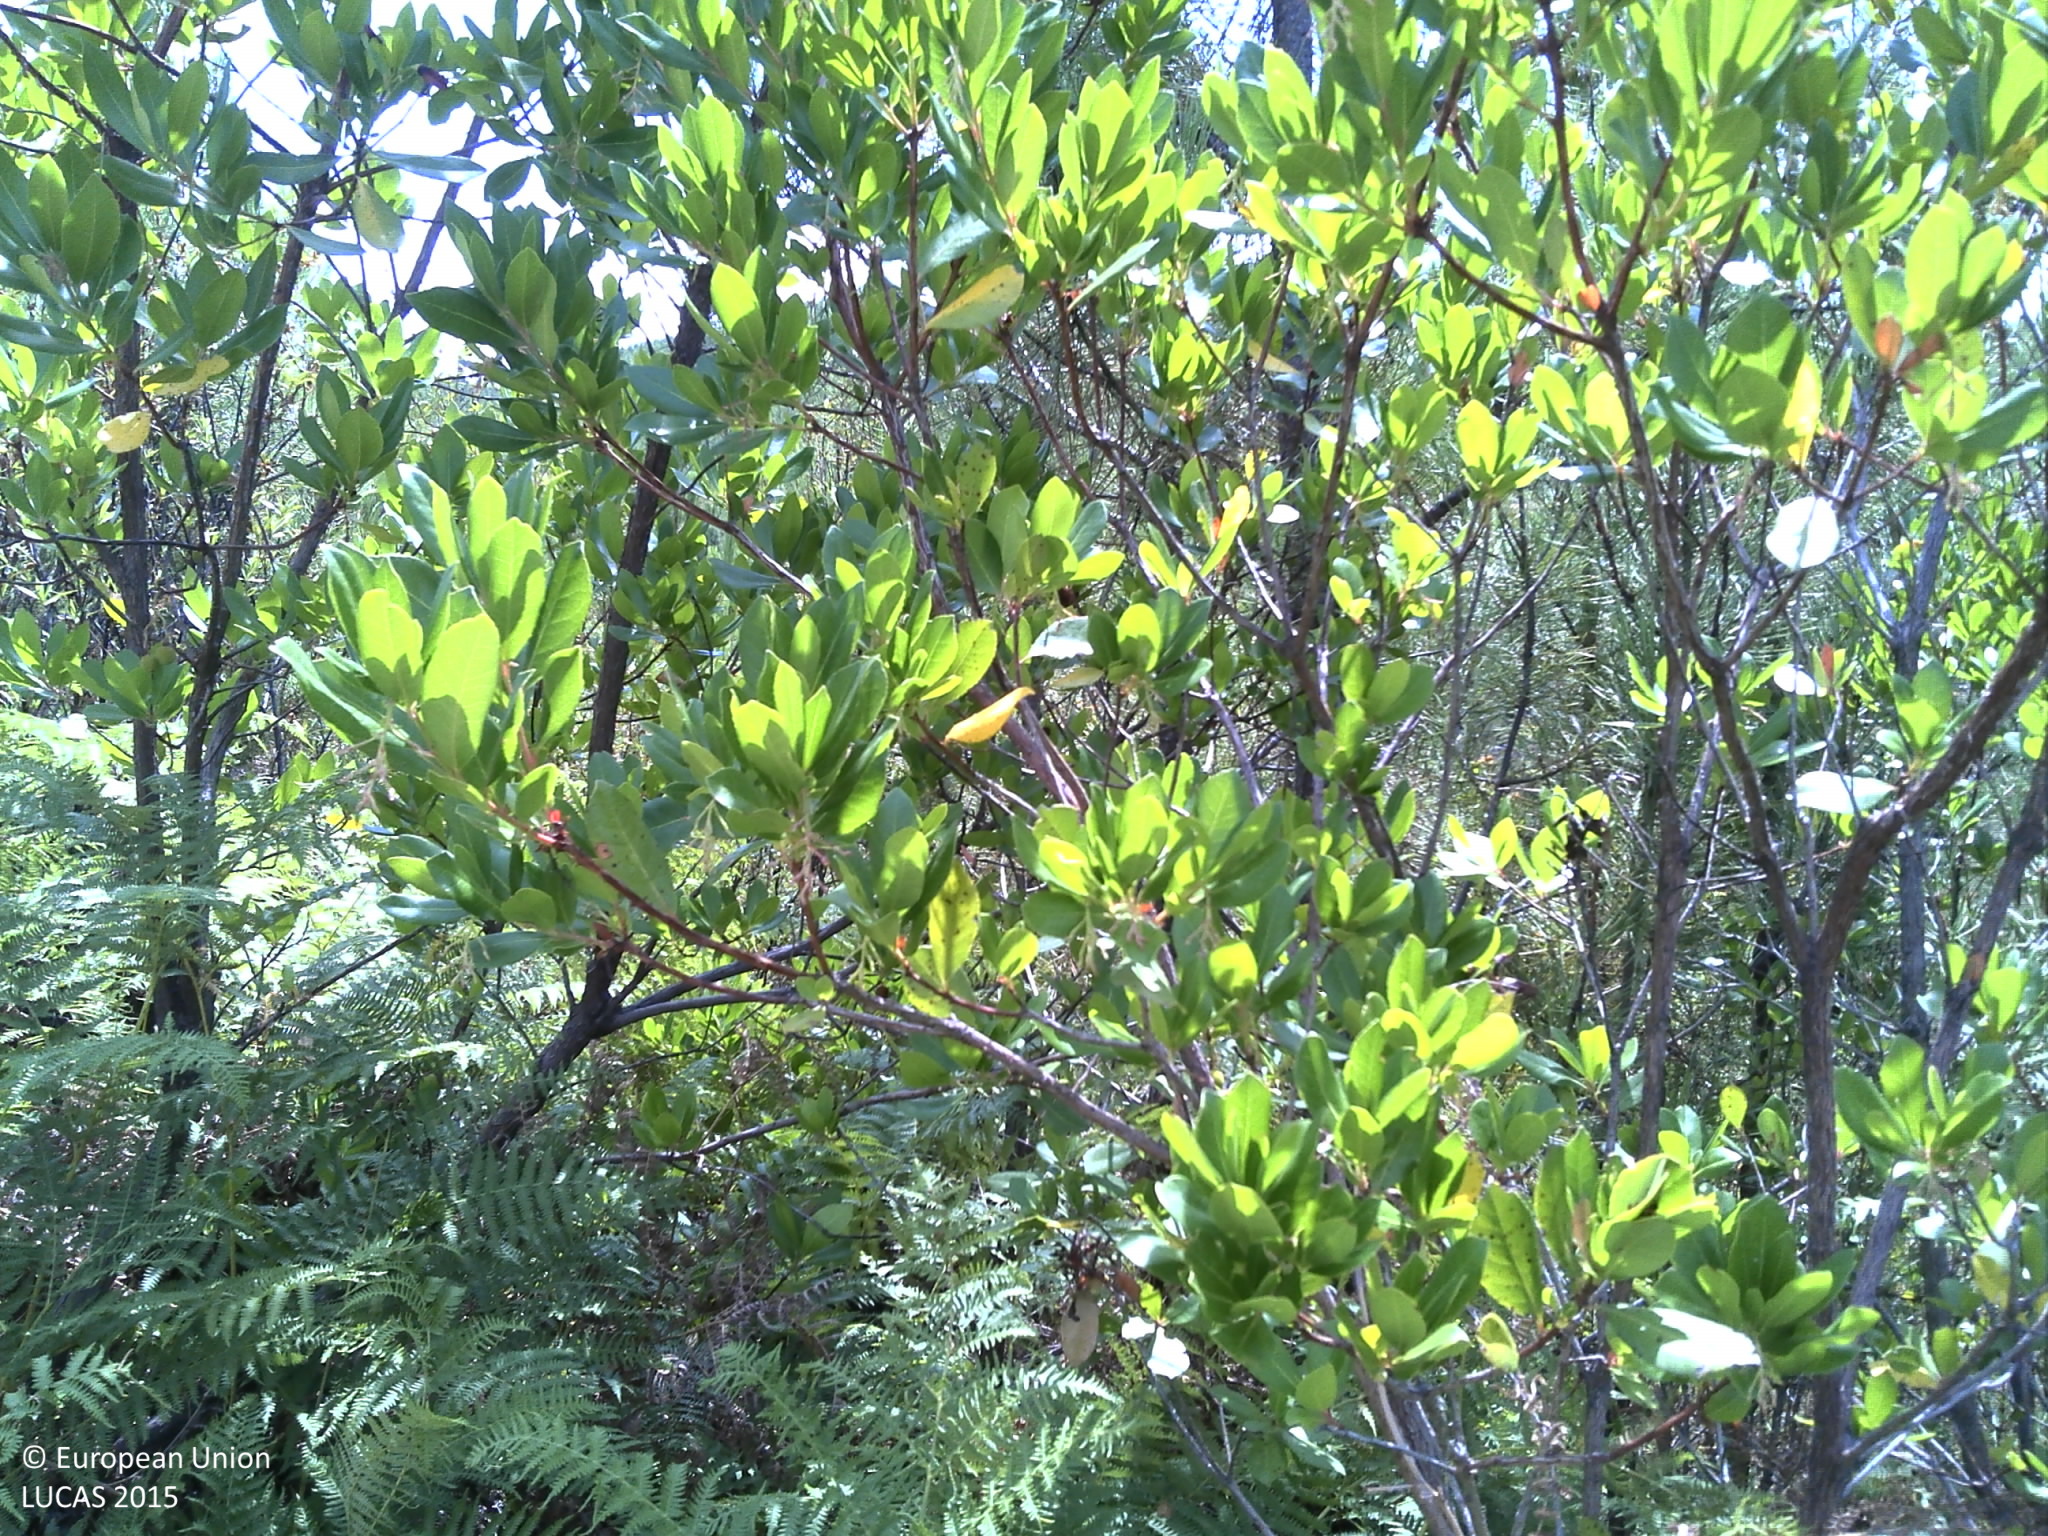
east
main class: Woodland
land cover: Pine dominated coniferous woodland
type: coniferous forest of the mediterranean region
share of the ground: 25 - 50 %
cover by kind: shrubs 50 %, coniferous forest trees 30 %, unconsolidated bare surface 20 %
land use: Forestry
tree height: < 5 m
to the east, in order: Pine dominated coniferous woodland; Dry stone walls; Pine dominated coniferous woodland; Dry stone walls; Pine dominated coniferous woodland; Dry stone walls; Pine dominated coniferous woodland; Dry stone walls; Pine dominated coniferous woodland; Dry stone walls; Shrubland with sparse tree cover; Rivers and streams; Shrubland with sparse tree cover; Pine dominated coniferous woodland; Paved roads, cycling and walking lanes; Pine dominated coniferous woodland
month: July
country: PT
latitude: 39.8417
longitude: -7.8121
